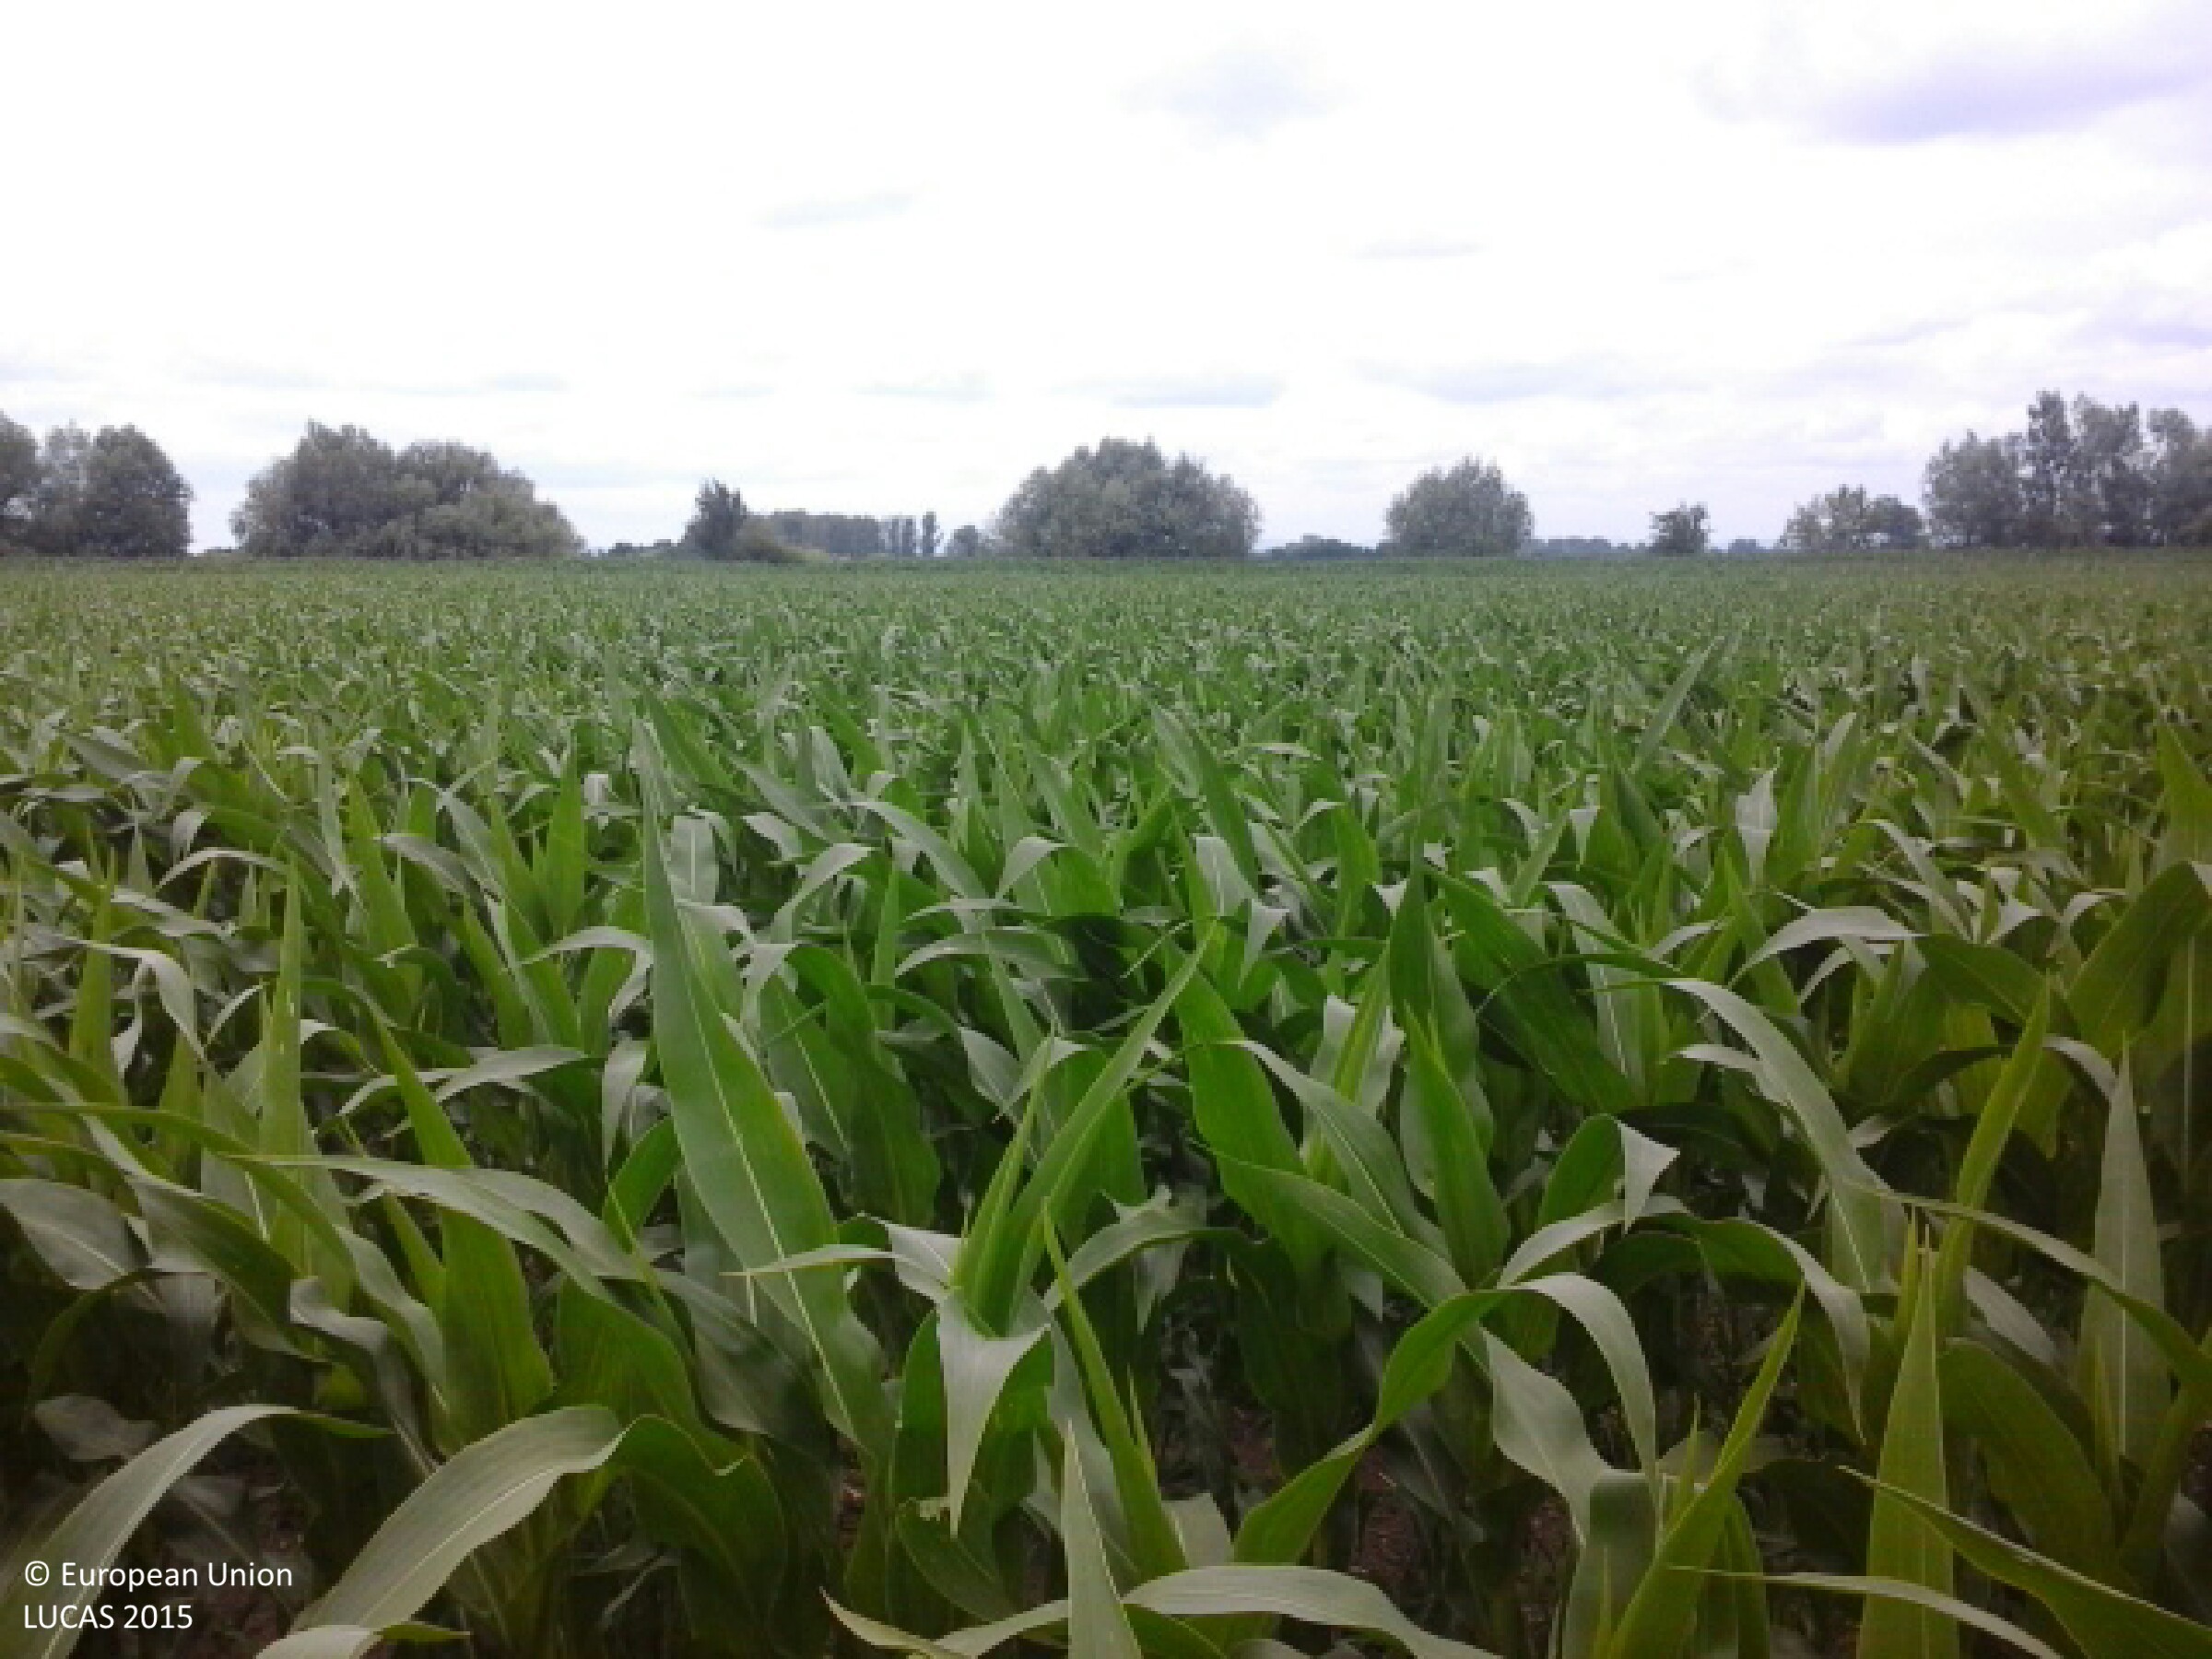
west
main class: Cropland
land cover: Maize
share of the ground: > 75 %
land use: Agriculture (excluding fallow land and kitchen gardens)
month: June
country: HU
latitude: 48.1675
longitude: 21.8154
